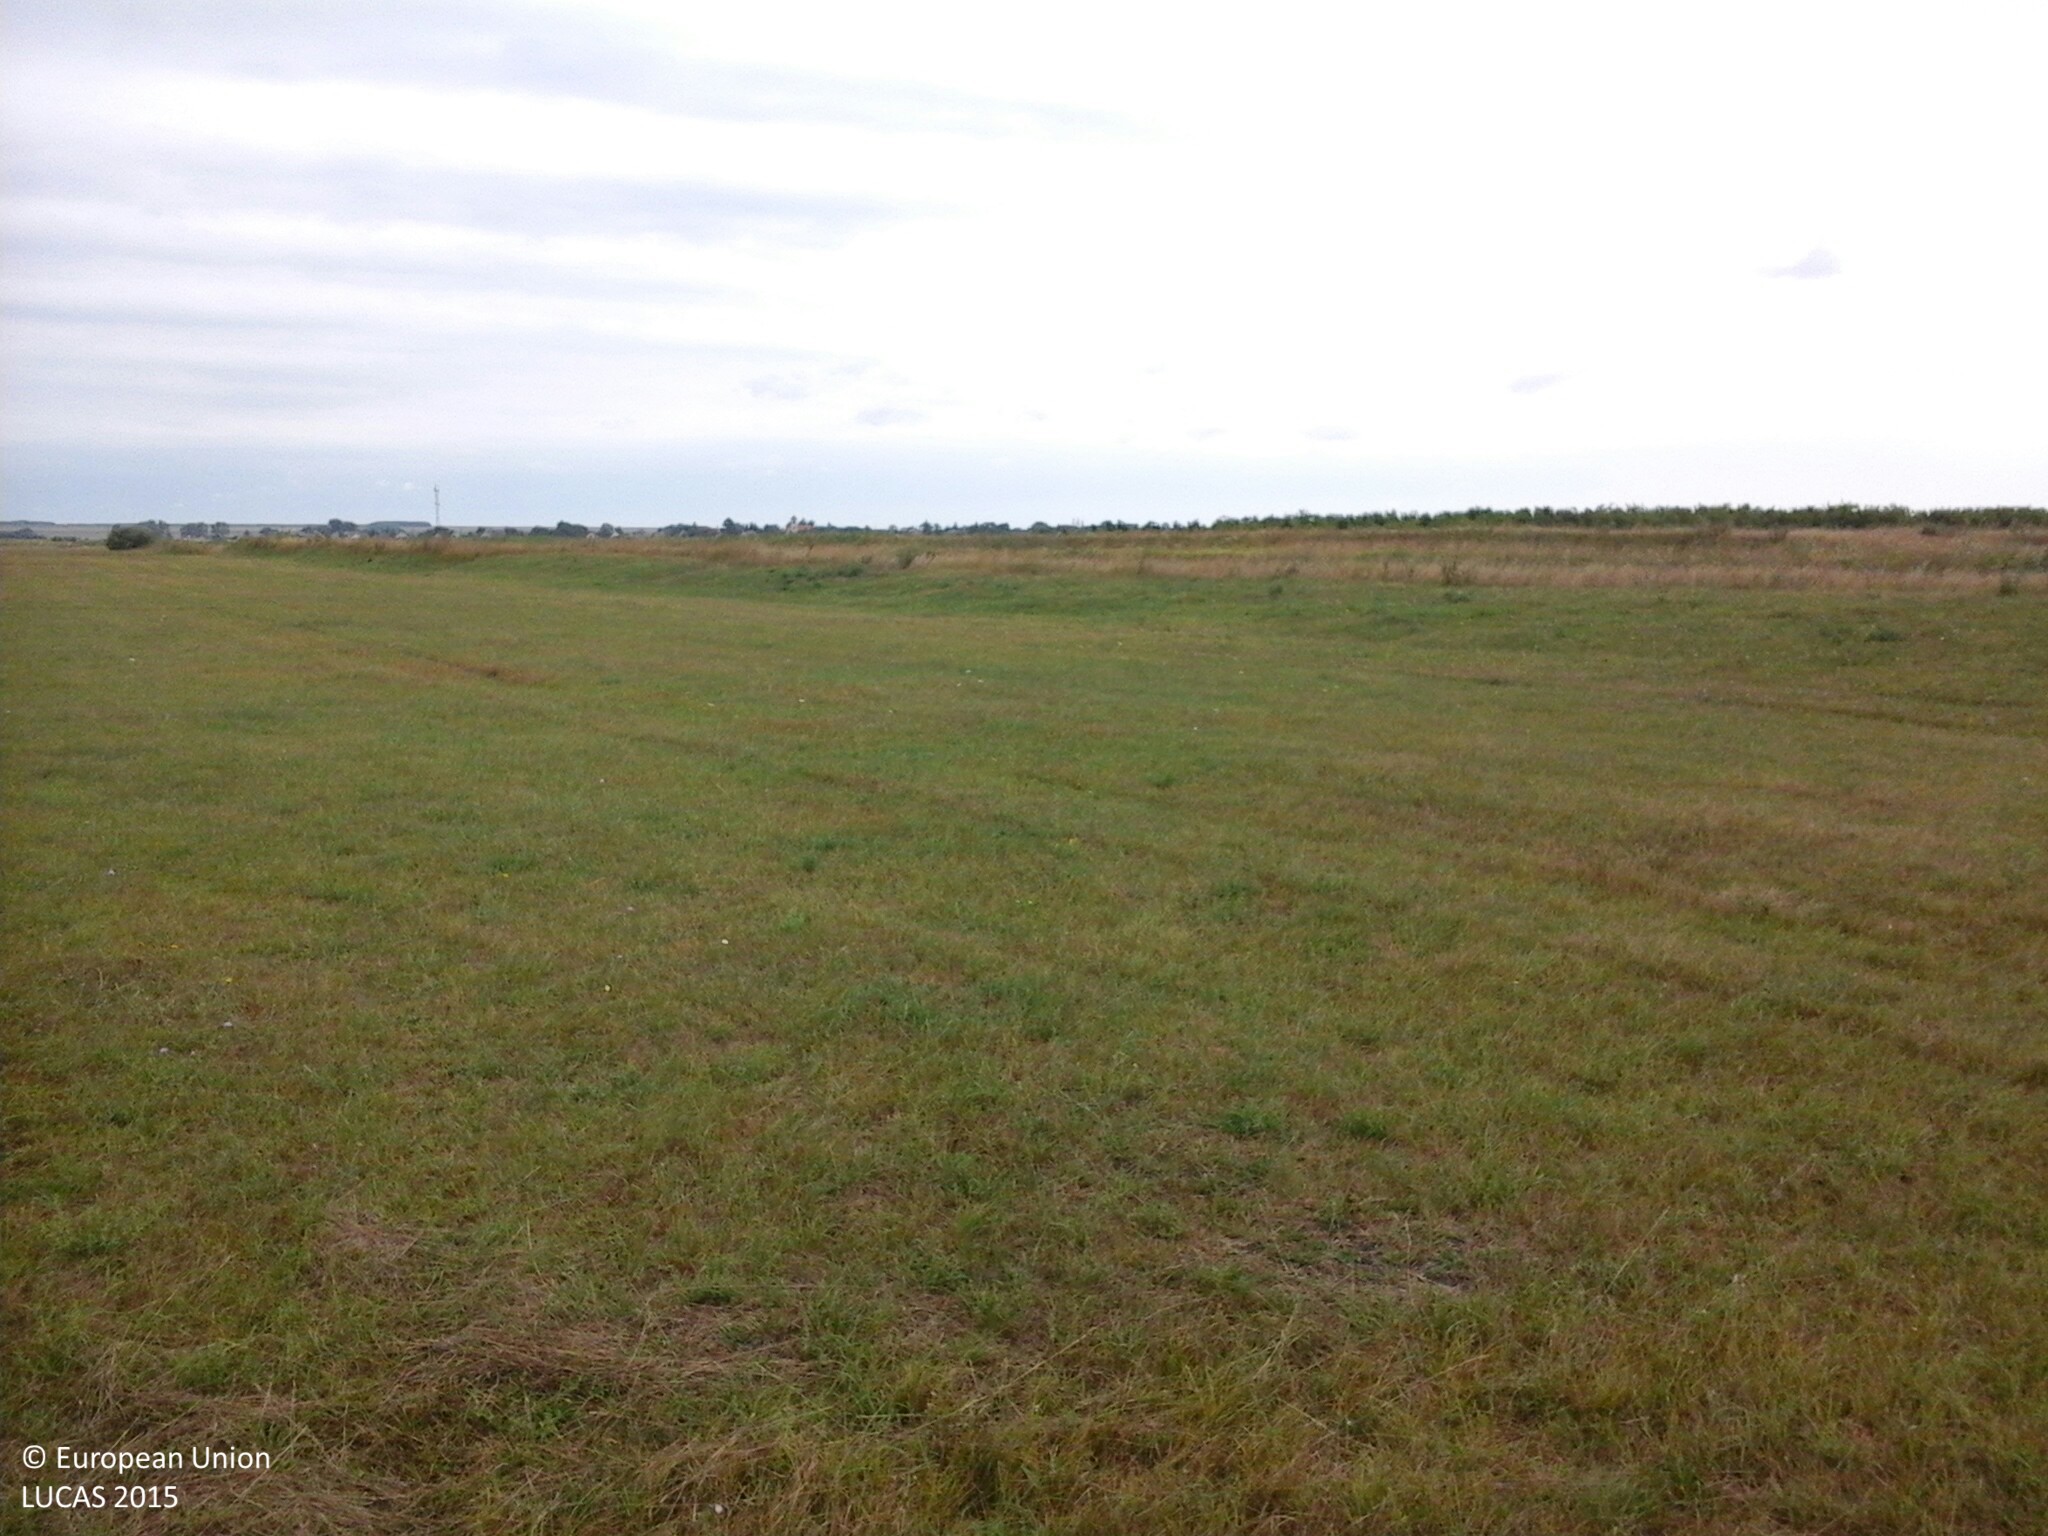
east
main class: Grassland
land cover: Grassland without tree/shrub cover
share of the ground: > 75 %
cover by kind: herbaceous plants 100 %
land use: Agriculture (excluding fallow land and kitchen gardens)
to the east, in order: Grassland without tree/shrub cover; Tracks; Spontaneously vegetated surfaces; Inland fresh running water; Spontaneously vegetated surfaces; Tracks; Grassland without tree/shrub cover; Tracks; Grassland without tree/shrub cover
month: July
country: HU
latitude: 47.0063
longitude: 18.5221
